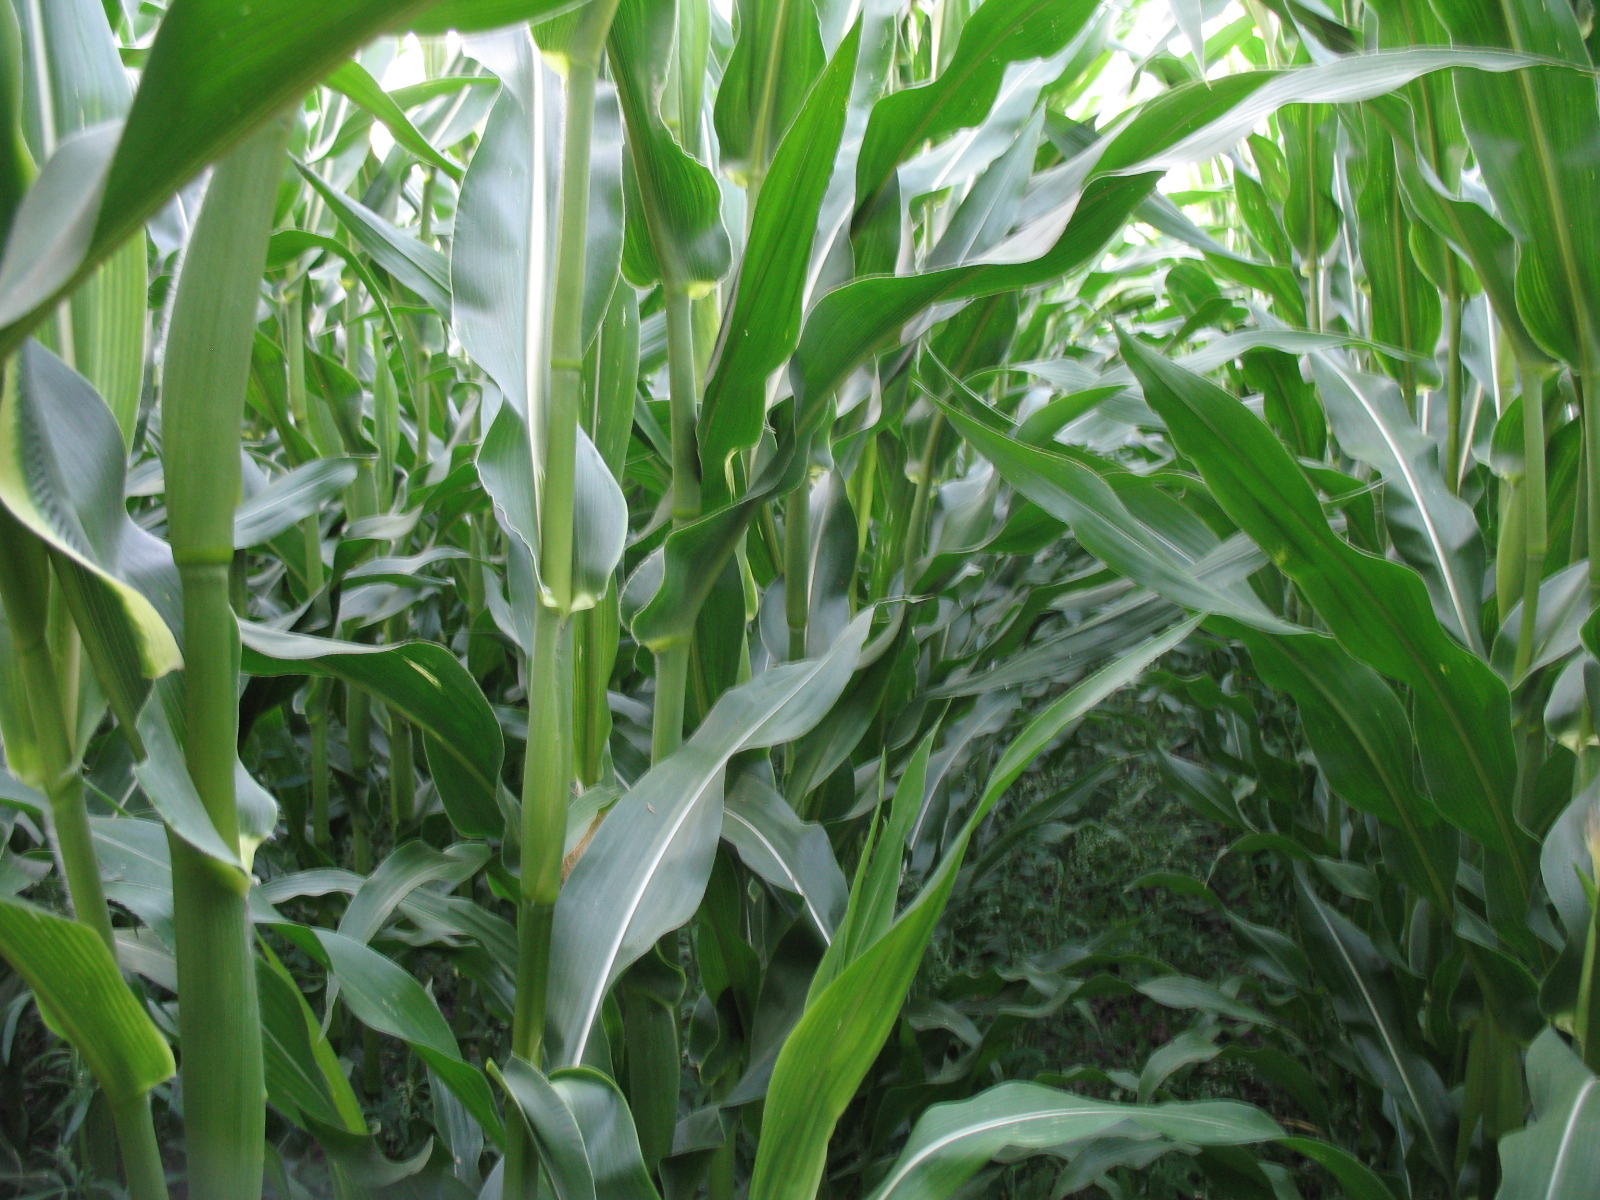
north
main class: Cropland
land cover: Maize
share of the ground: > 75 %
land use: Agriculture (excluding fallow land and kitchen gardens)
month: August
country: LV
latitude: 56.3594
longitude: 25.4803
